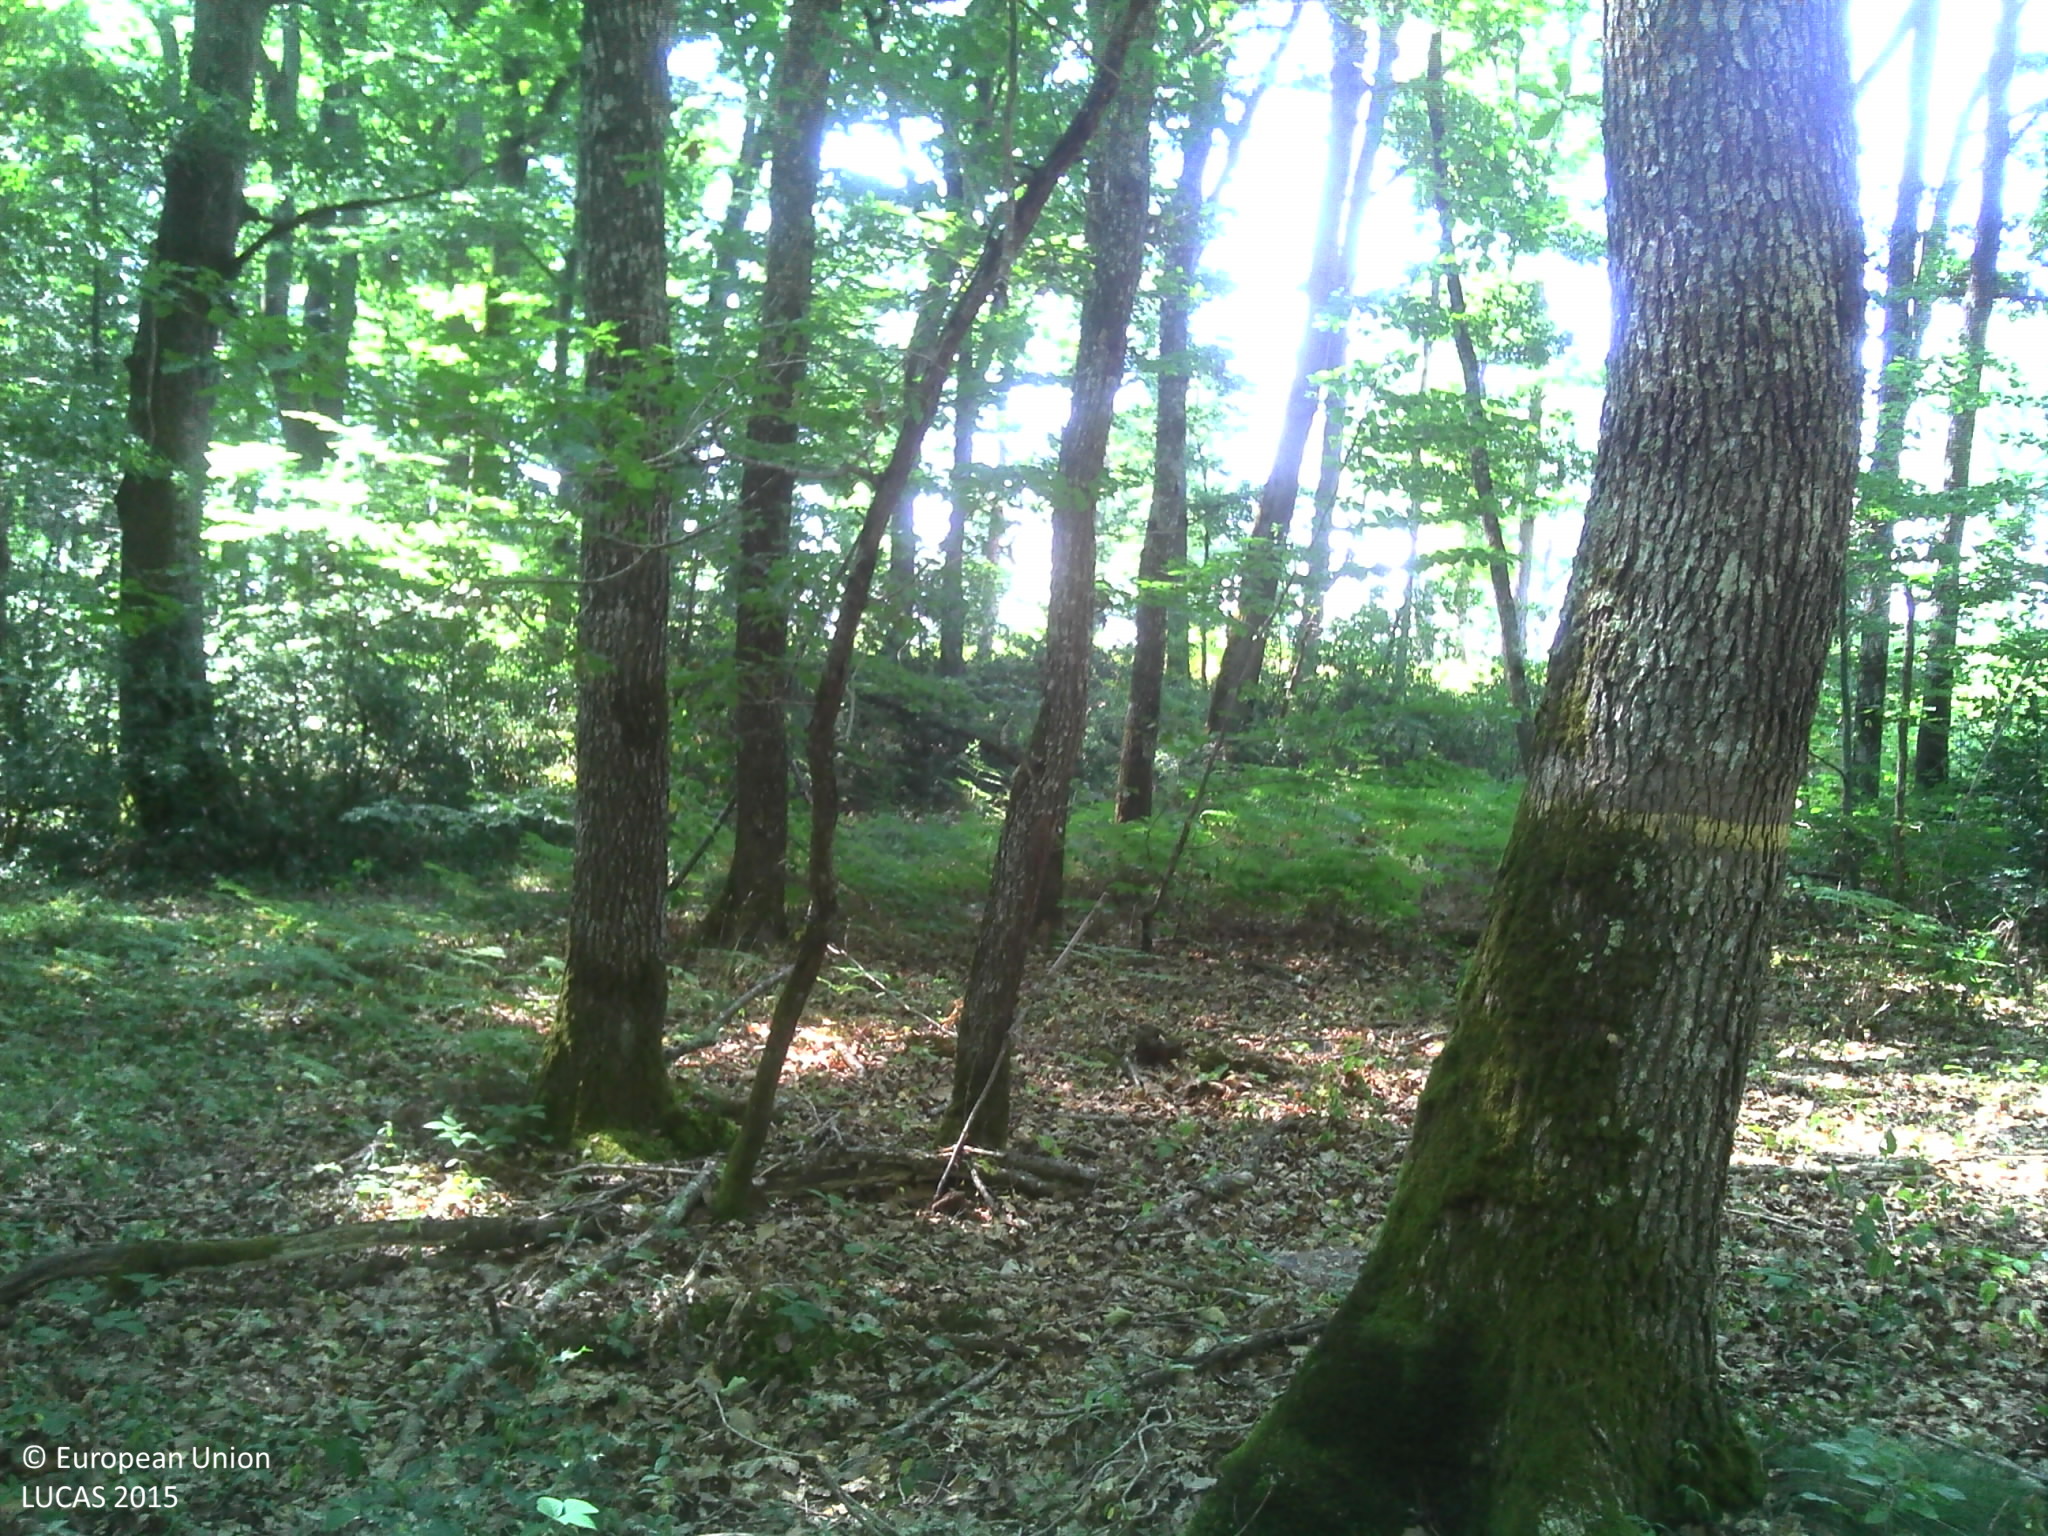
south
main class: Woodland
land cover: Broadleaved woodland
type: mesophytic deciduous forest
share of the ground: > 75 %
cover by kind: broadleaved forest trees 95 %, herbaceous plants 5 %
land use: Forestry
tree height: > 5 m
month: July
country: FR
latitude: 46.4303
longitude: 2.7477
